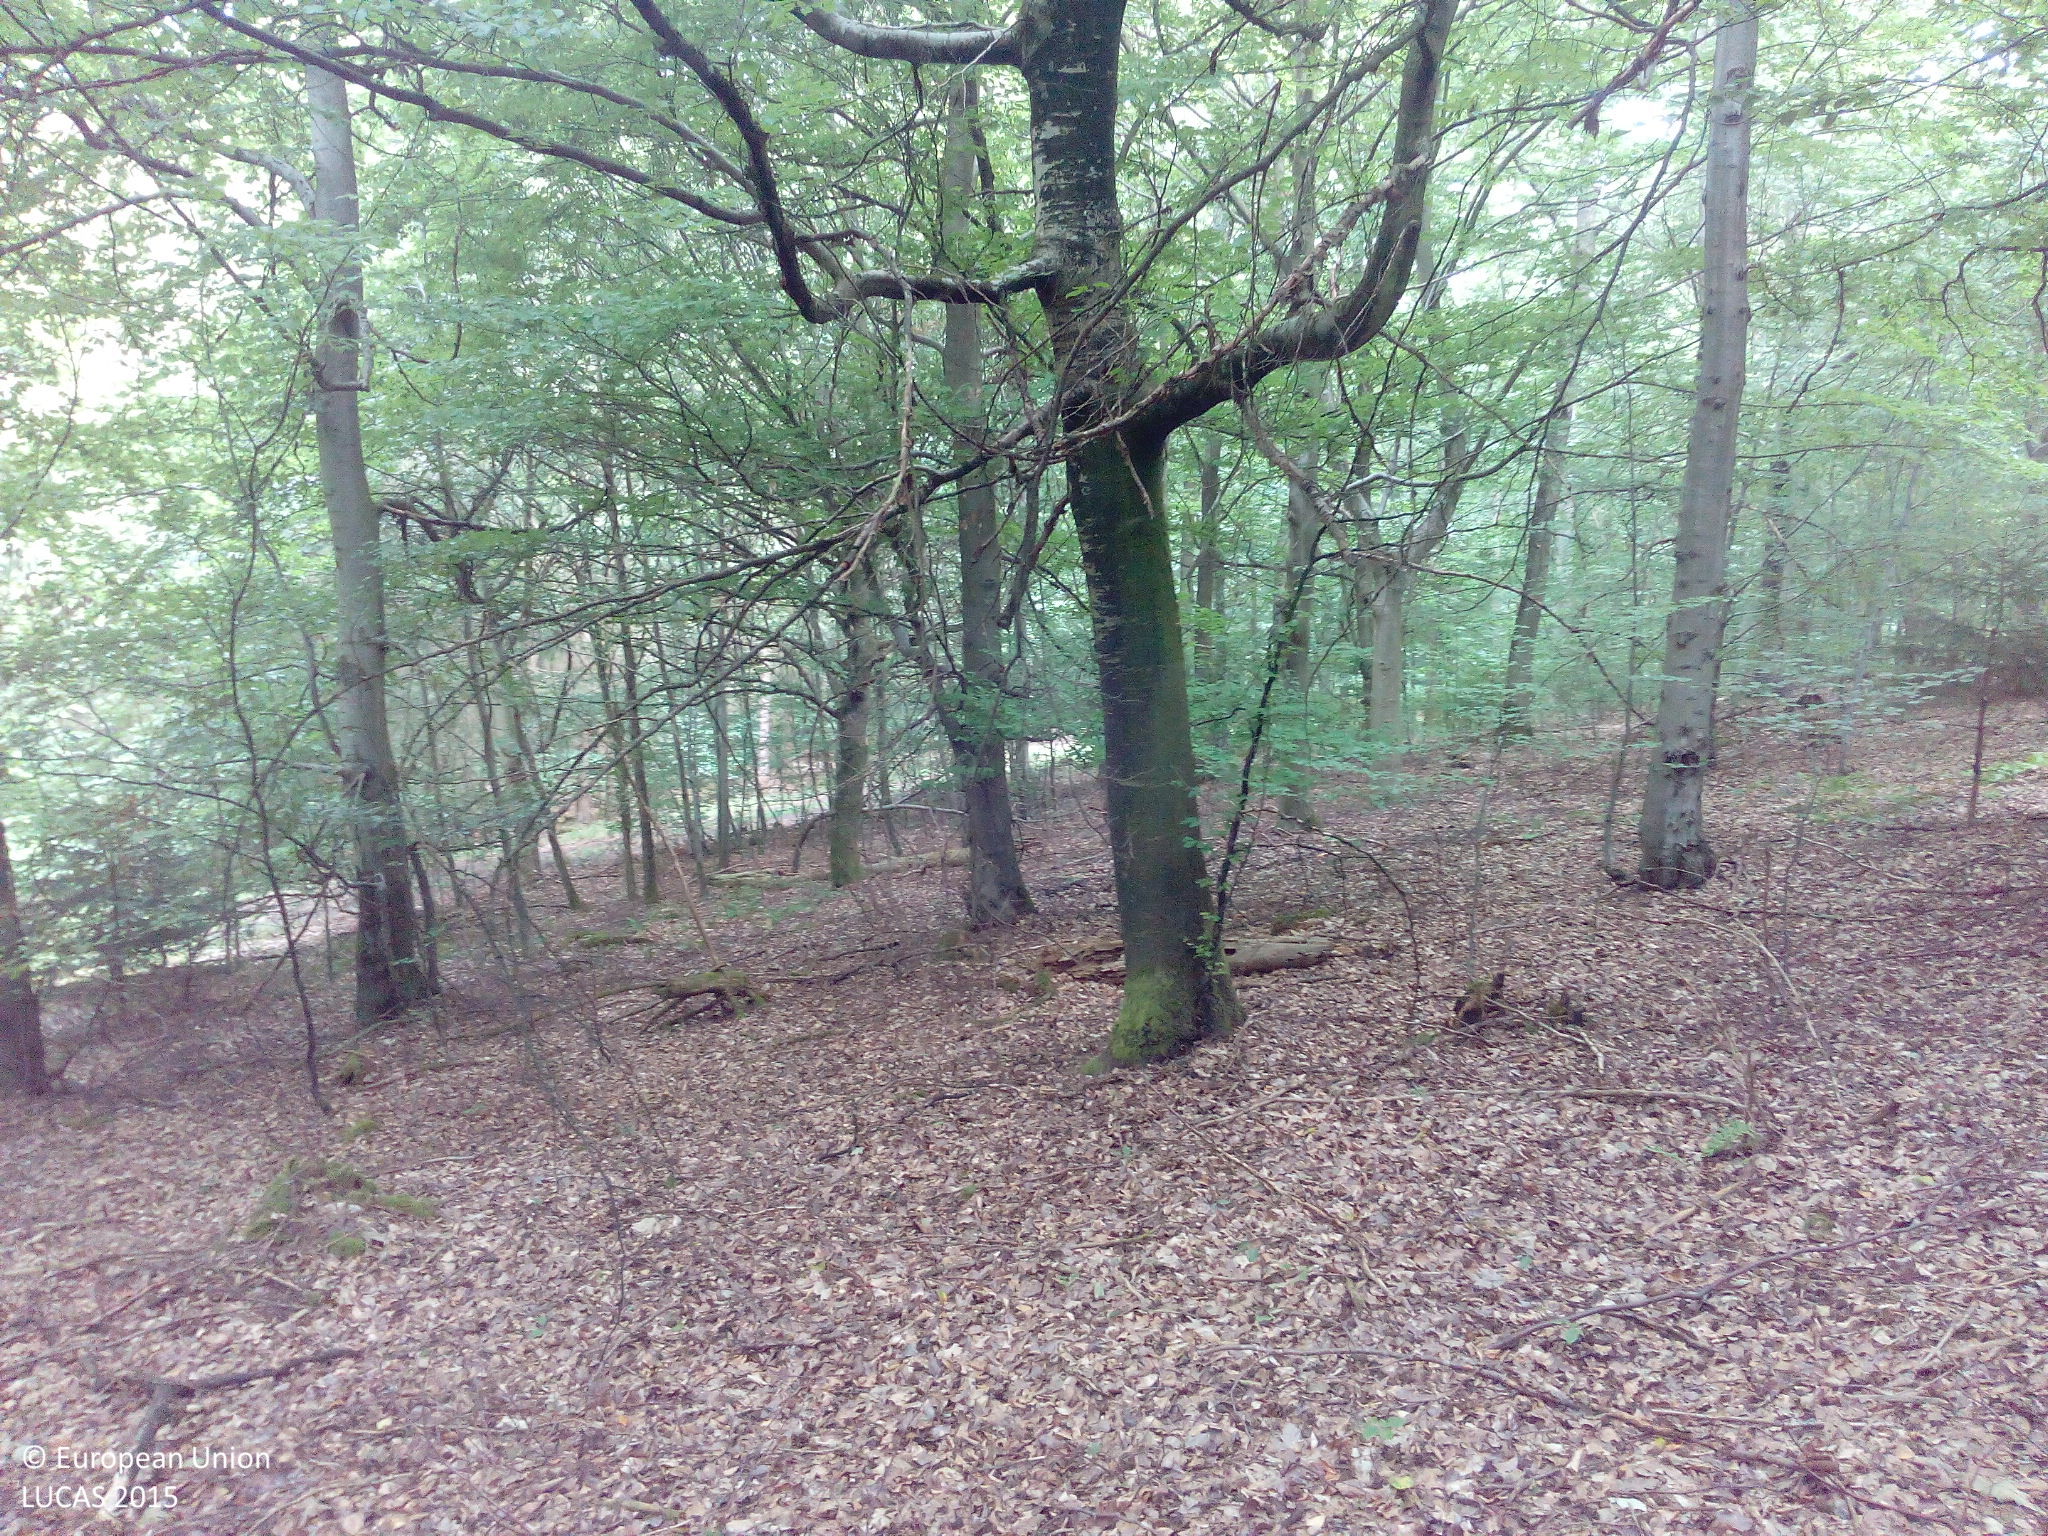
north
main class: Woodland
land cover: Spruce dominated mixed woodland
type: mesophytic deciduous forest
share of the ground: > 75 %
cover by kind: broadleaved forest trees 65 %, coniferous forest trees 25 %, lichens and mosses 5 %, unconsolidated bare surface 5 %
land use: Forestry
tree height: > 5 m
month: August
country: DE
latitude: 49.7254
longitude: 7.5173
